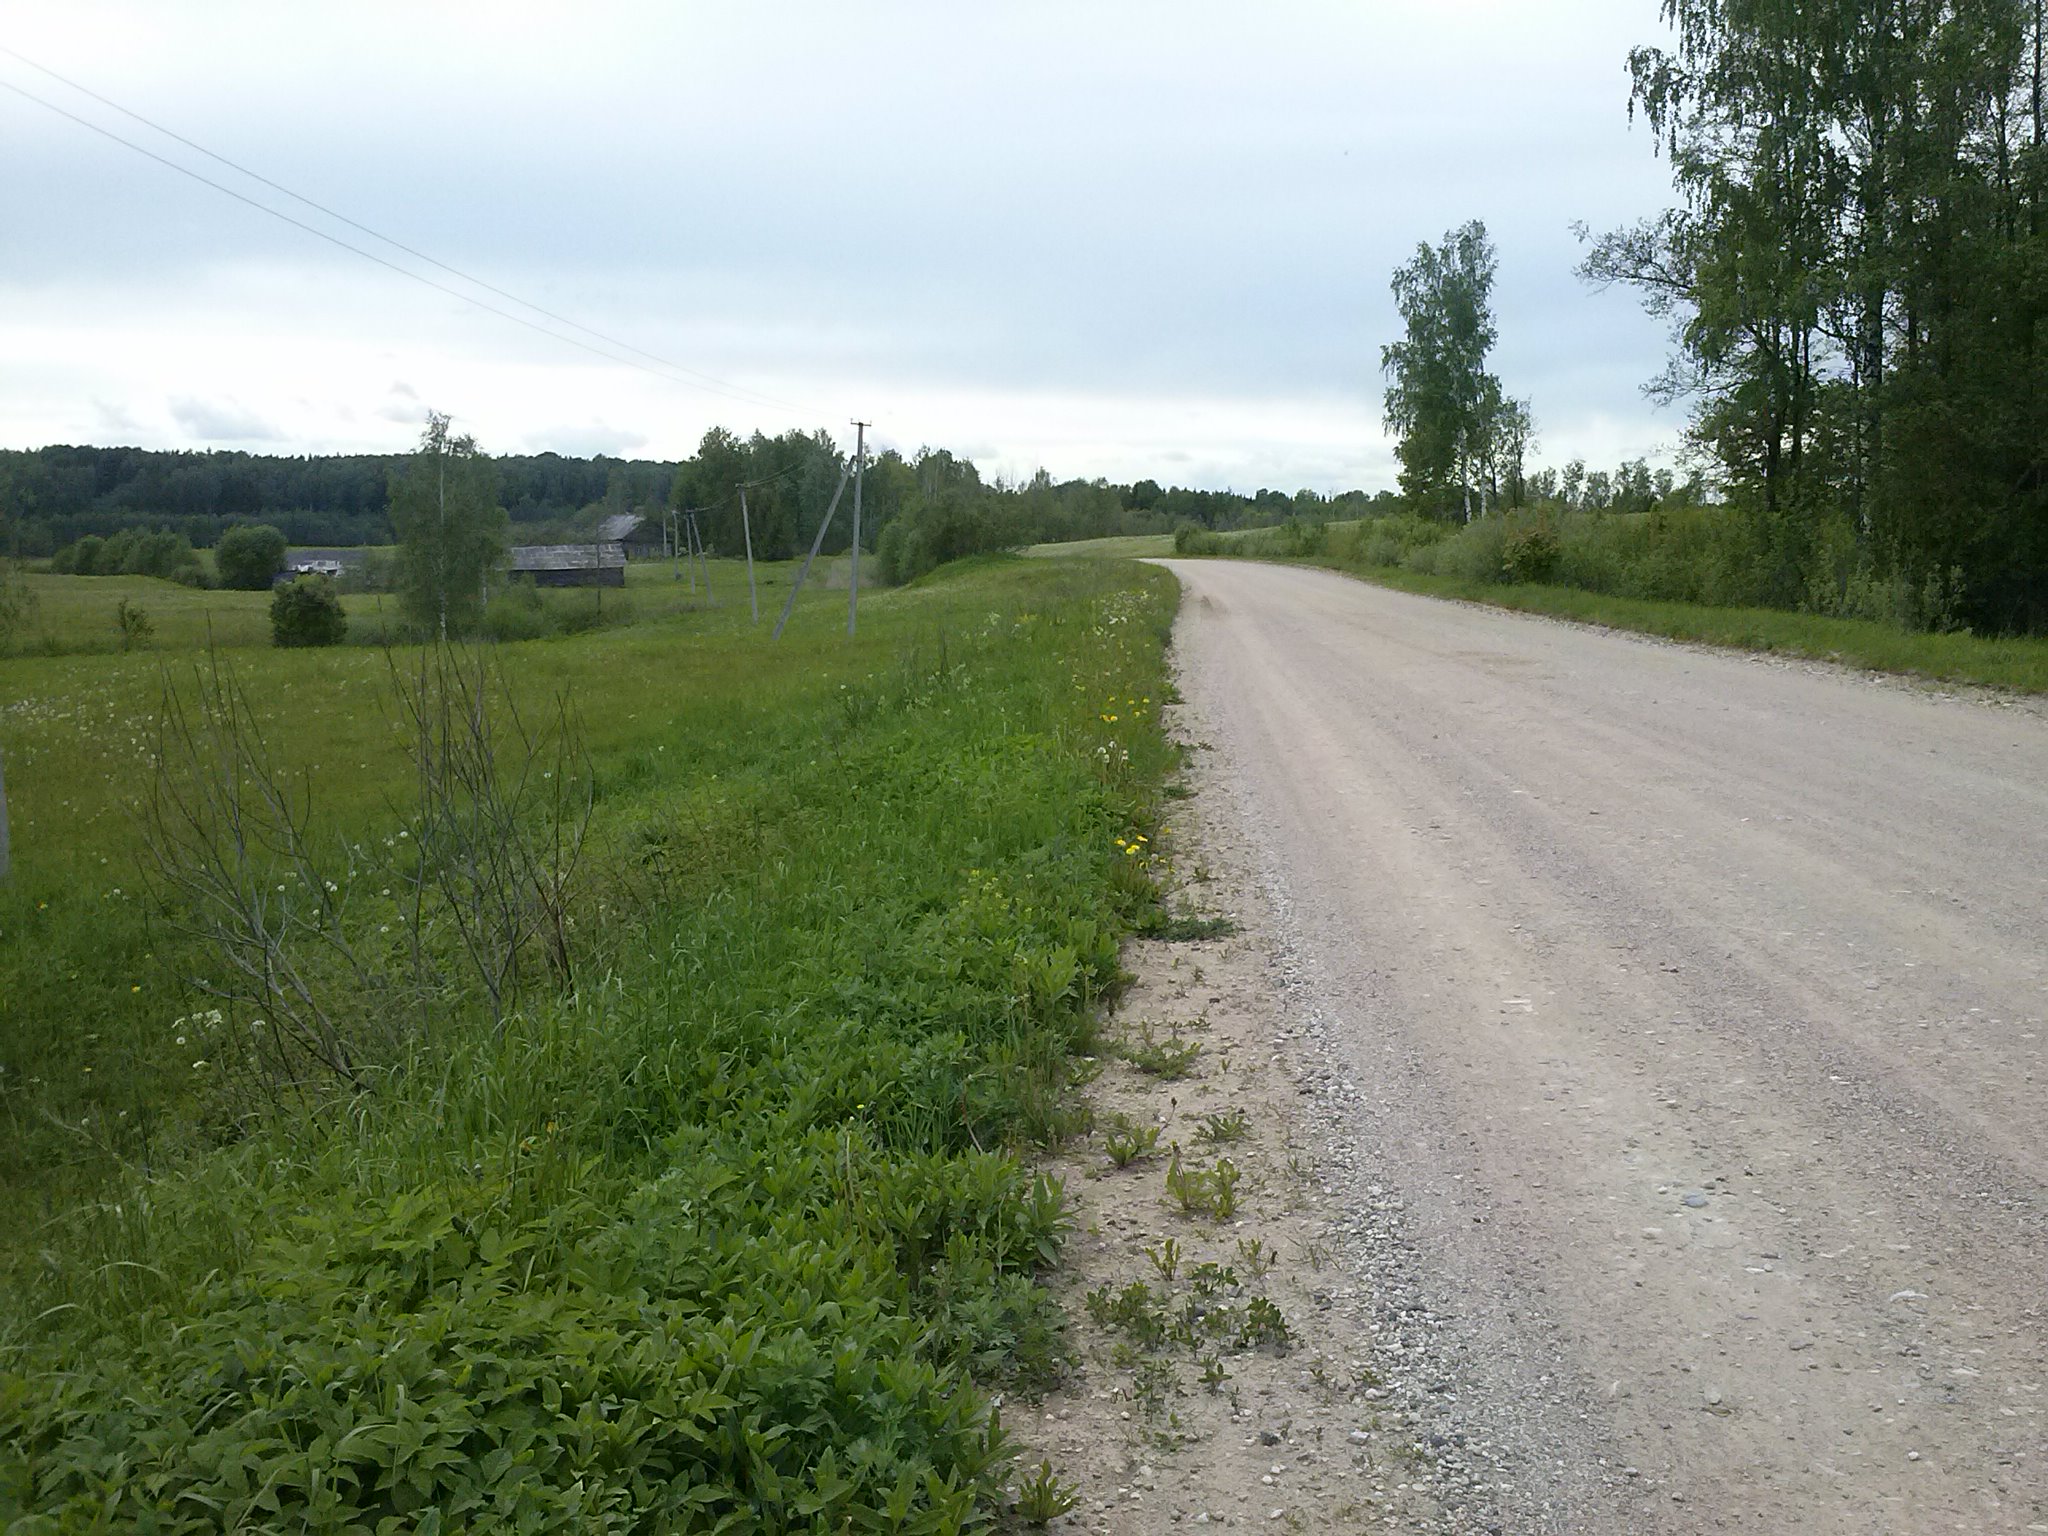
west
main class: Grassland
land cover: Grassland without tree/shrub cover
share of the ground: > 75 %
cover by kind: herbaceous plants 100 %
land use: Agriculture (excluding fallow land and kitchen gardens)
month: May
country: LV
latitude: 56.2617
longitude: 27.7705
